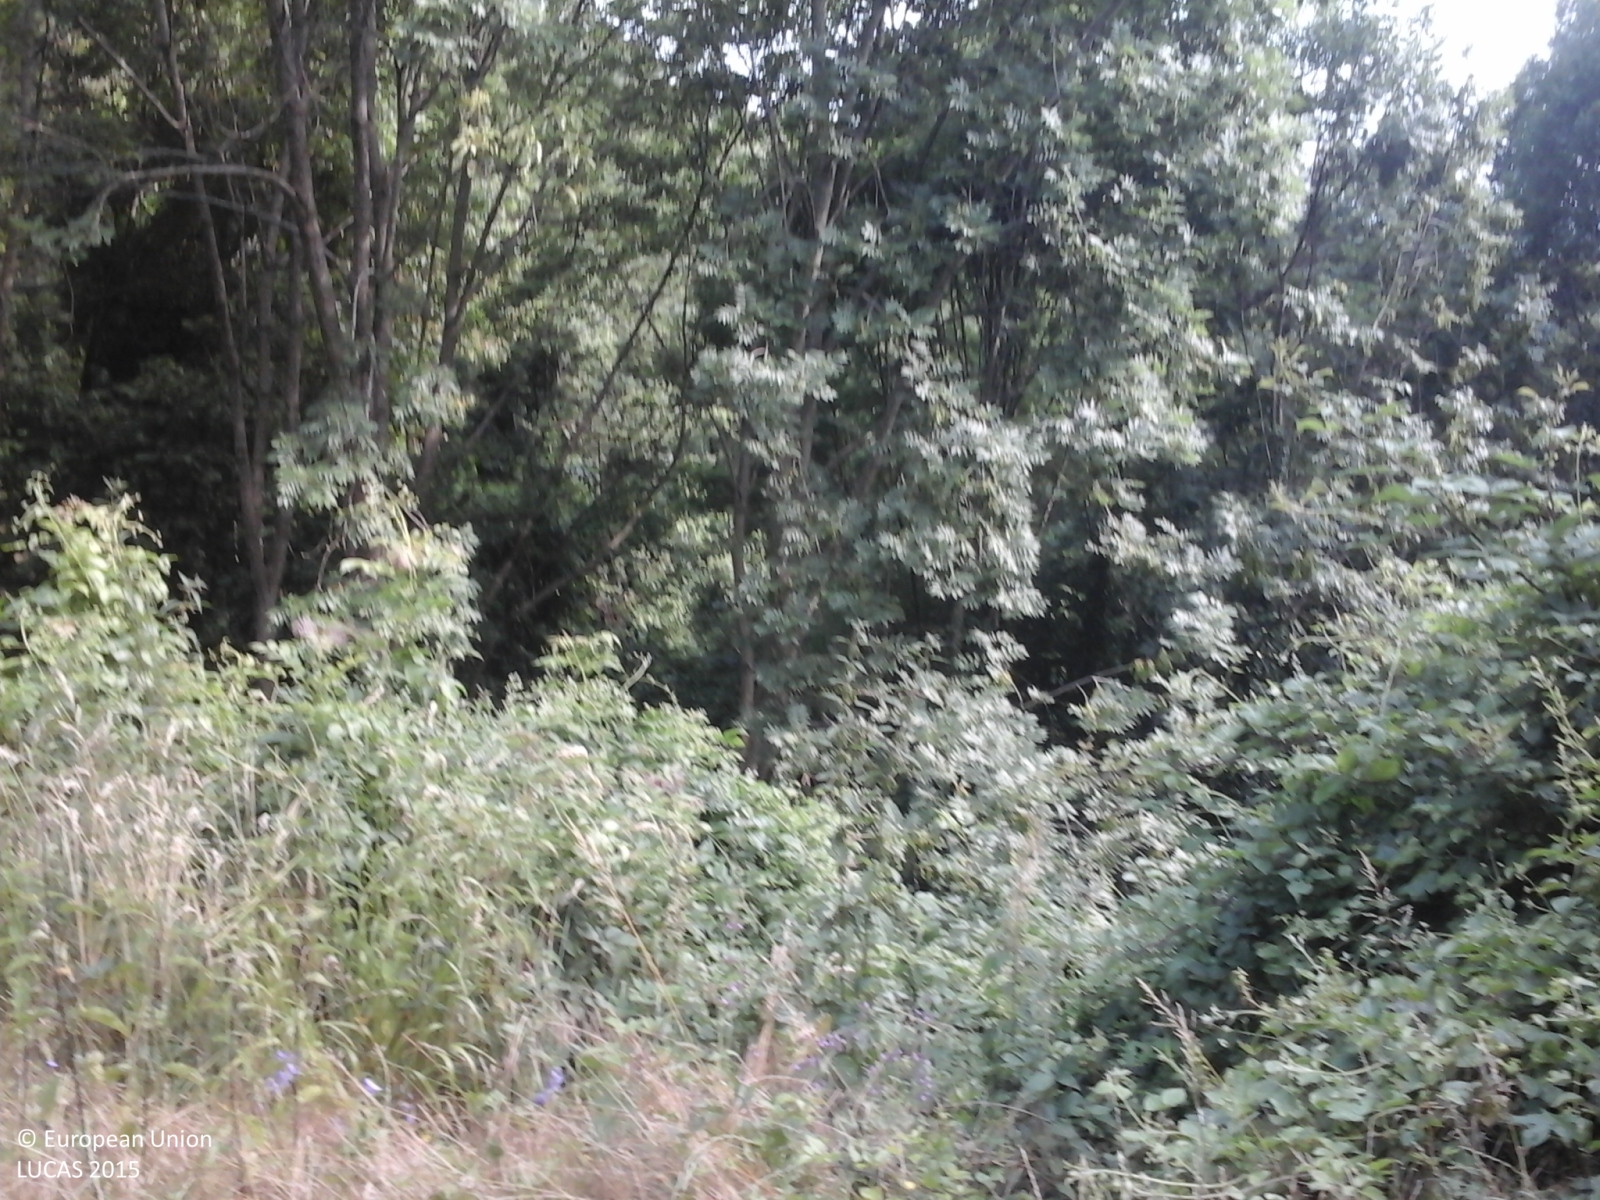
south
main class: Woodland
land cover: Broadleaved woodland
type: mesophytic deciduous forest
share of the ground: > 75 %
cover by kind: broadleaved forest trees 100 %
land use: Forestry
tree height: > 5 m
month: June
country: IT
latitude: 45.1605
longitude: 7.1931
